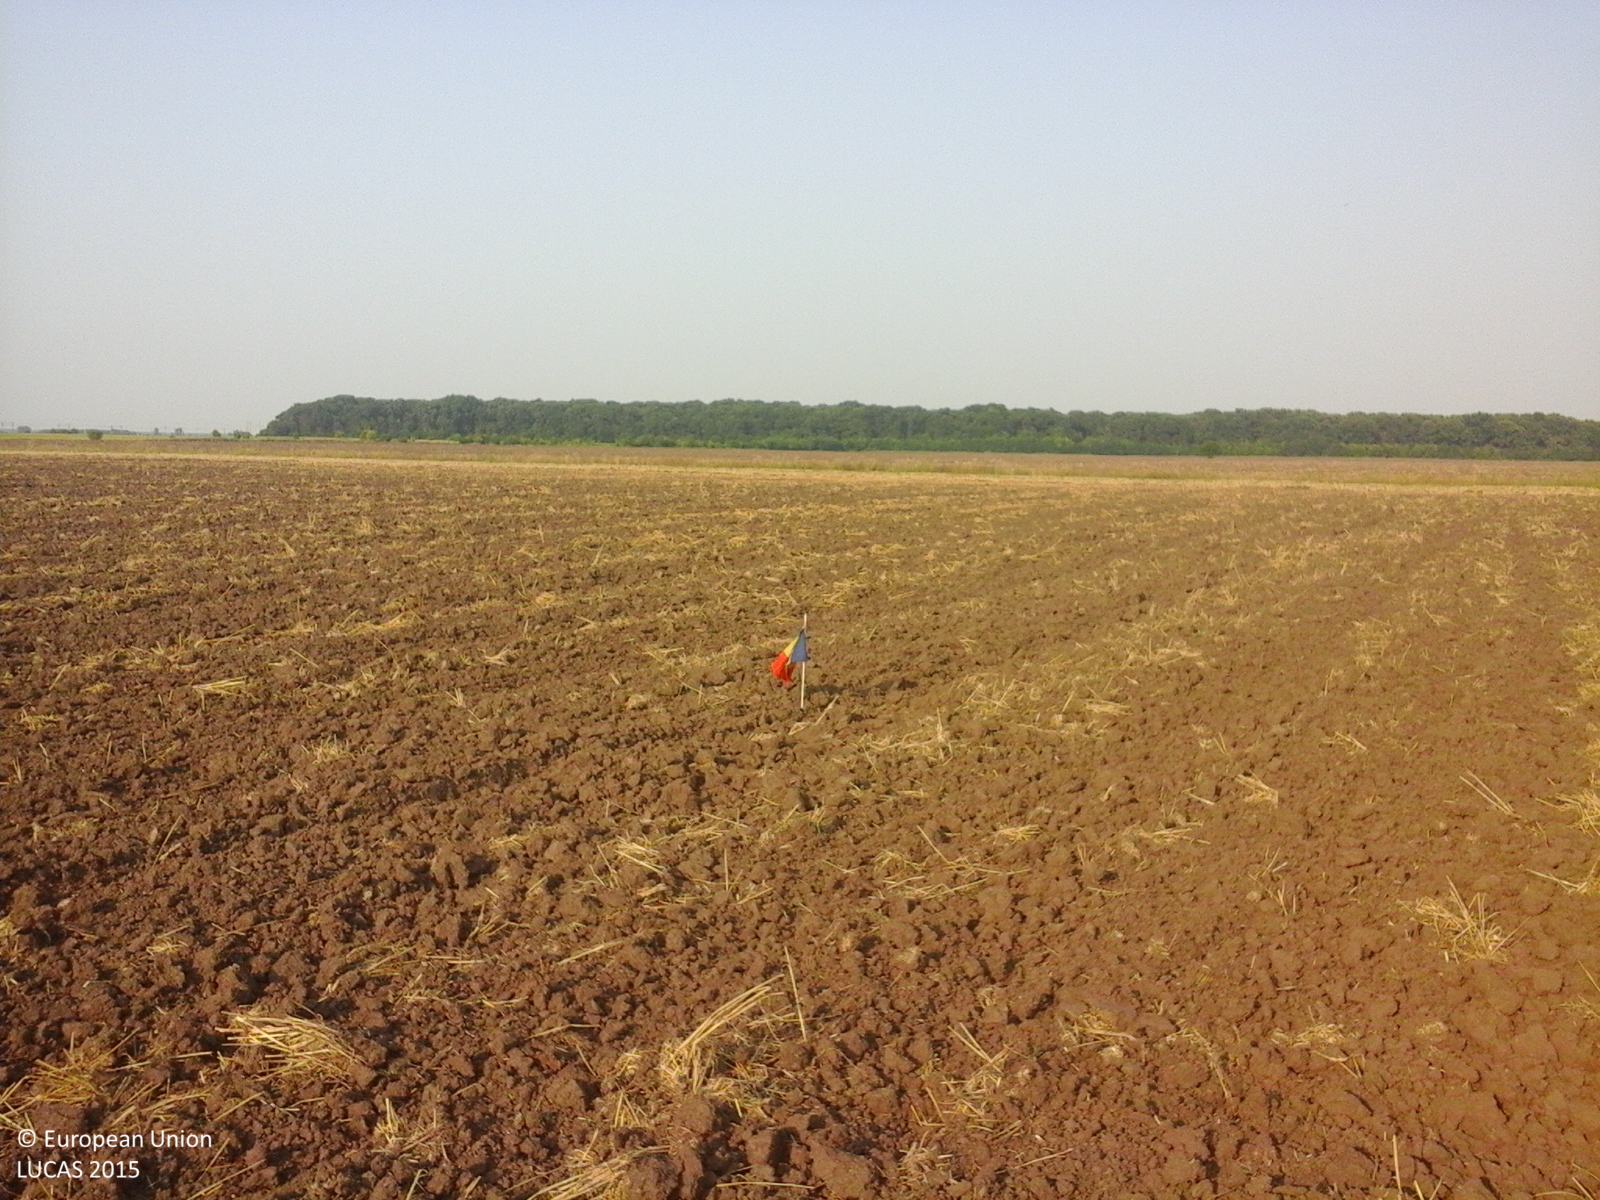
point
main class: Cropland
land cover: Common wheat
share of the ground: < 10 %
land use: Agriculture (excluding fallow land and kitchen gardens)
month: July
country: RO
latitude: 44.4481
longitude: 26.4108
